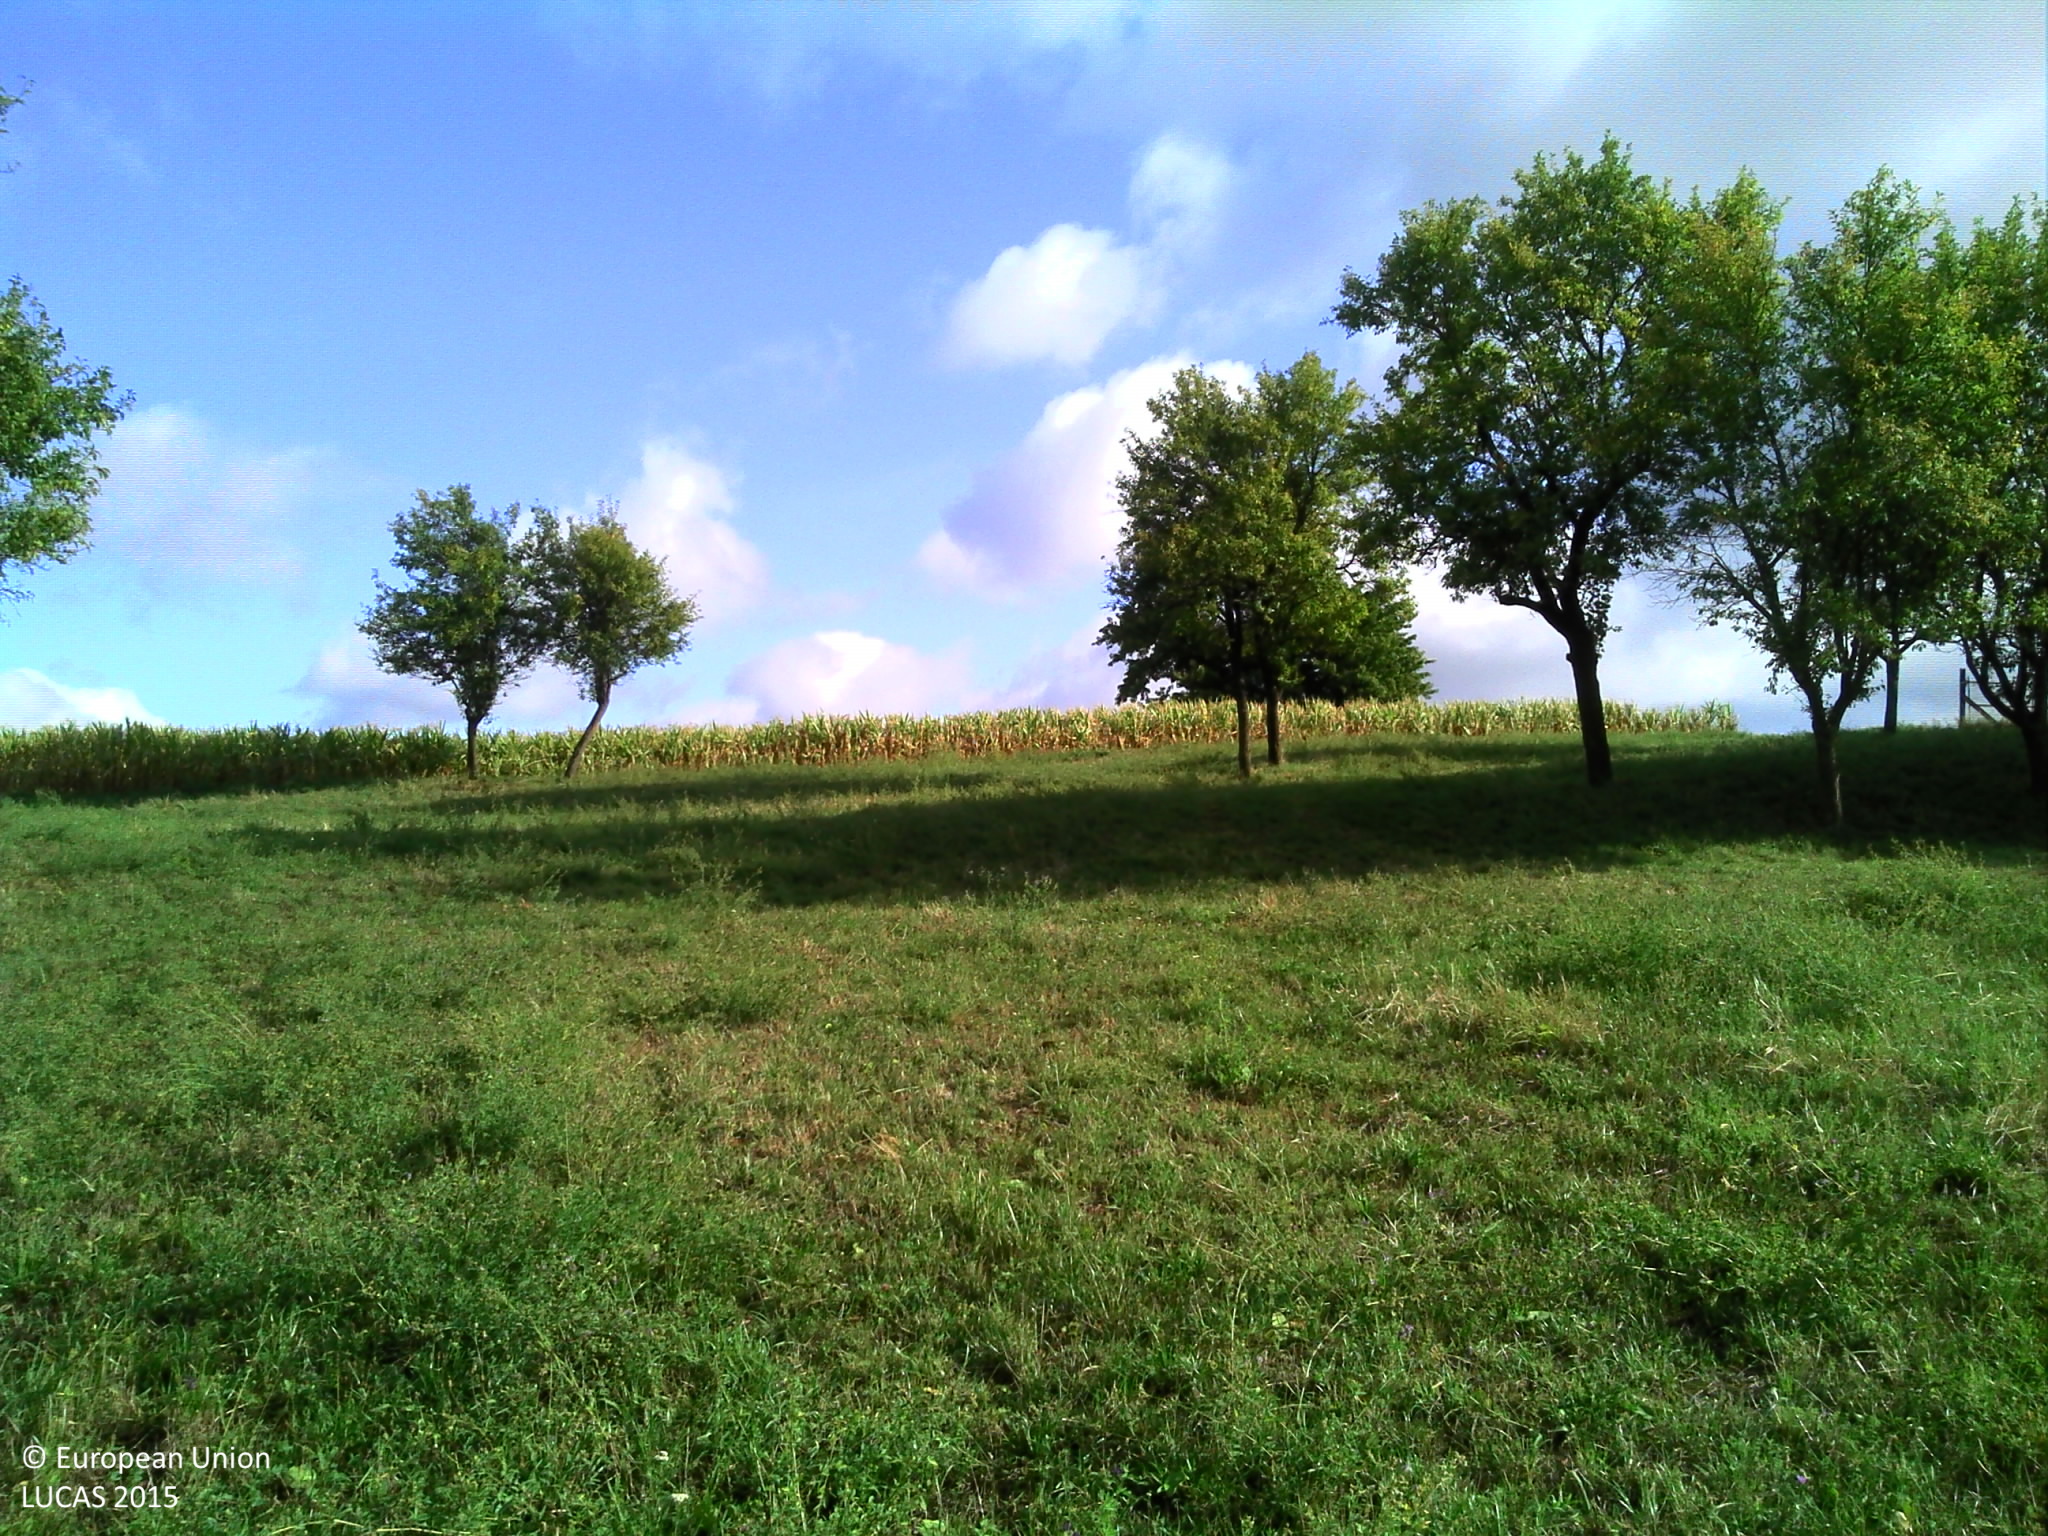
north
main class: Grassland
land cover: Grassland without tree/shrub cover
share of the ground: > 75 %
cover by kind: herbaceous plants 100 %
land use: Agriculture (excluding fallow land and kitchen gardens)
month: August
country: FR
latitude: 48.8092
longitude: 7.5905
